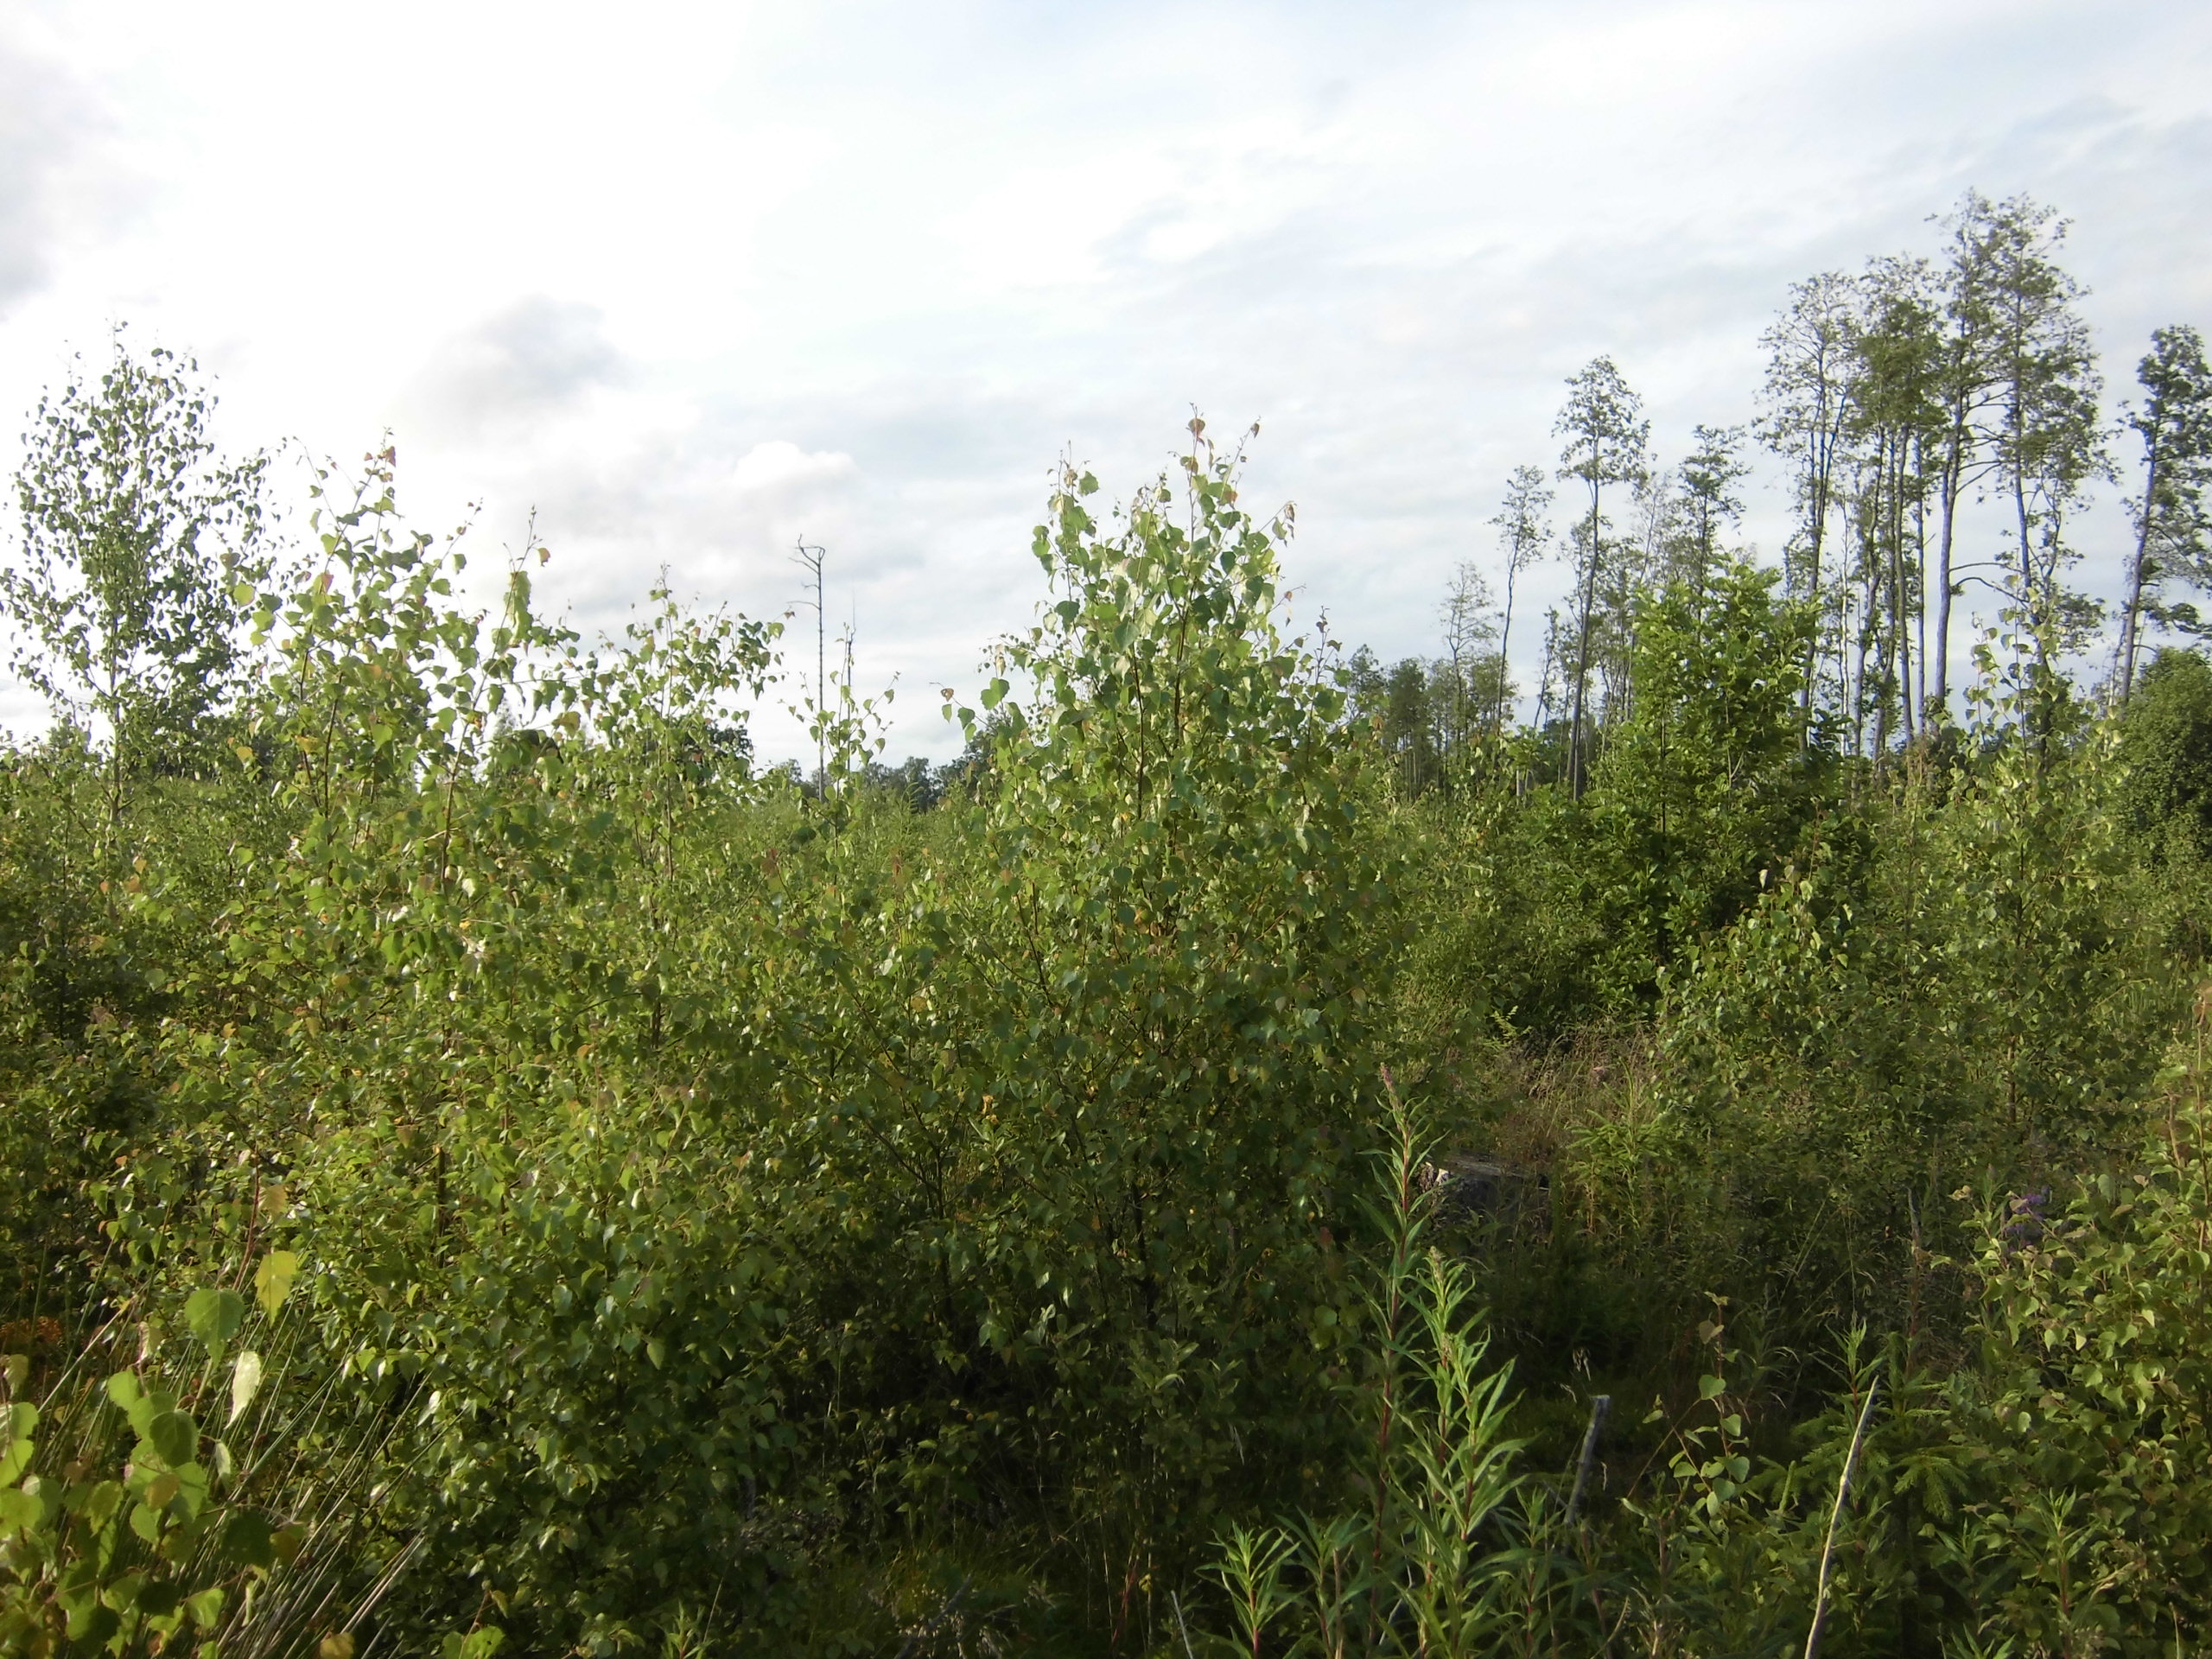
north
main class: Woodland
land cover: Broadleaved woodland
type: boreal forest
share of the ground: 50 - 75 %
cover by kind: broadleaved forest trees 65 %, herbaceous plants 20 %, coniferous forest trees 5 %, shrubs 5 %, lichens and mosses 5 %
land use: Forestry
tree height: < 5 m
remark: Clear cut
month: July
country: SE
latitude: 57.4833
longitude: 14.8497
